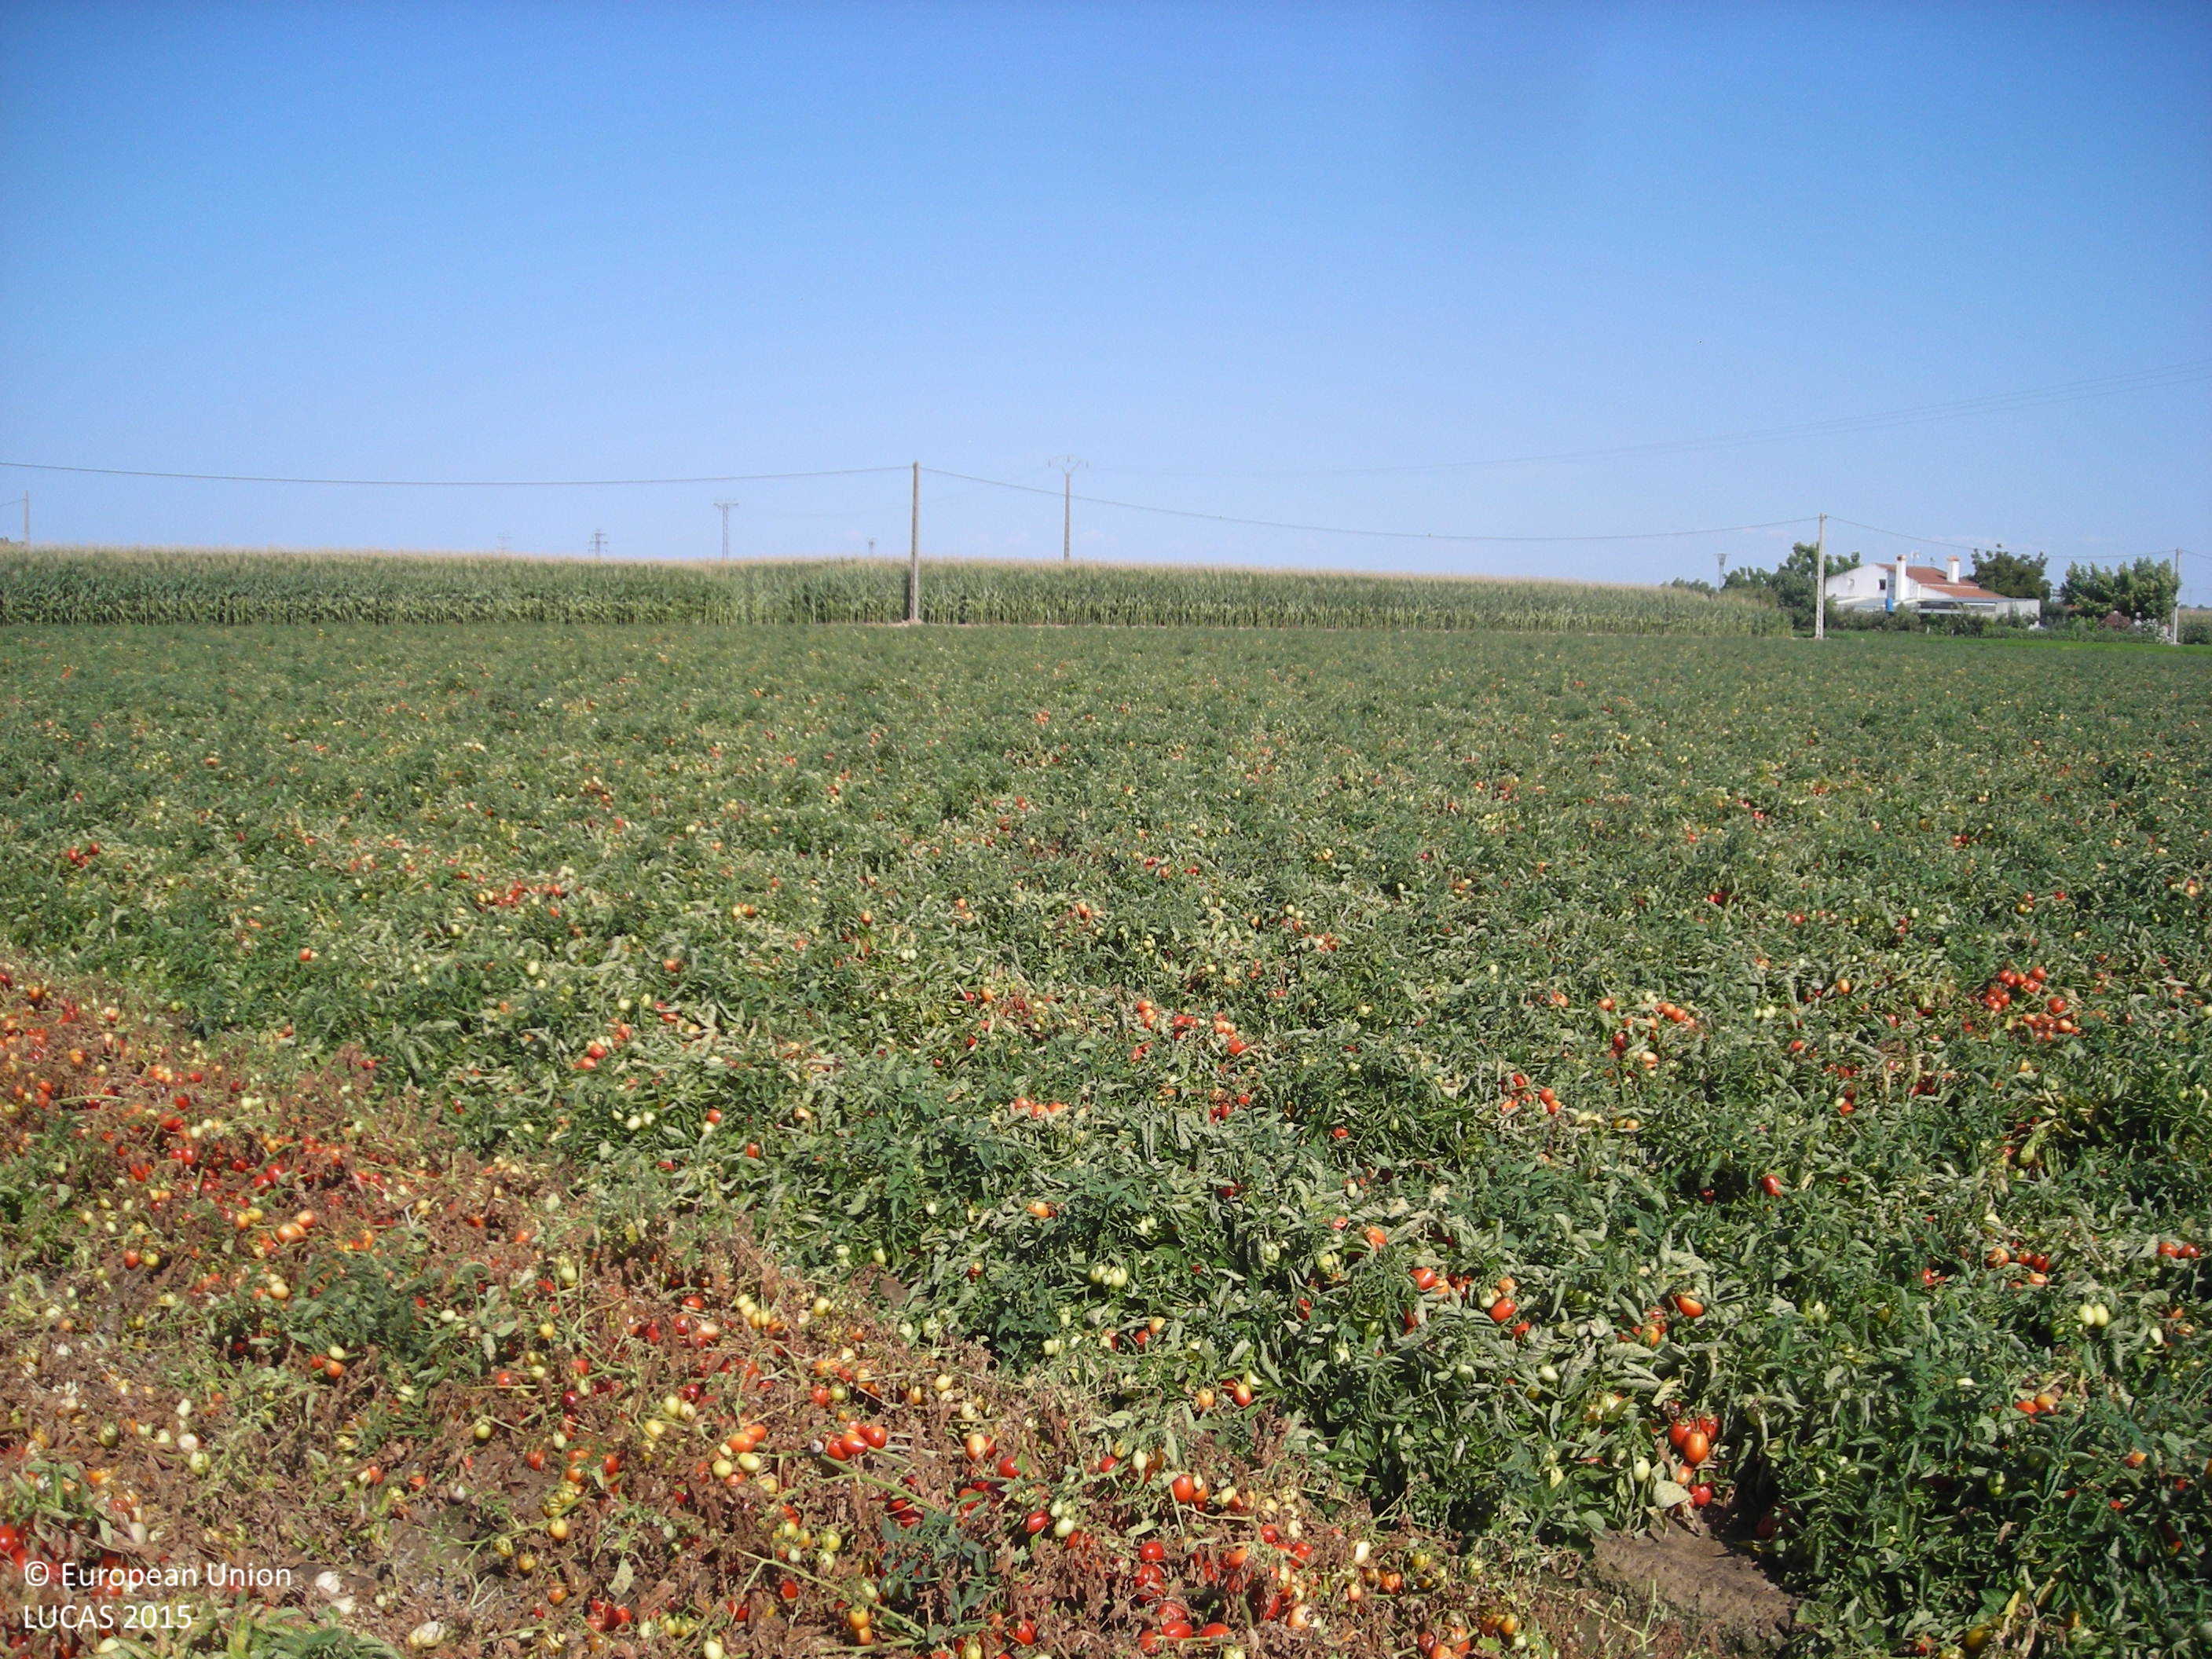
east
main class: Cropland
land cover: Tomatoes
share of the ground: > 75 %
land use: Agriculture (excluding fallow land and kitchen gardens)
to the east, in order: Tomatoes; Other bare soil; Maize
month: July
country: ES
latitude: 39.0088
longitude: -5.8361
